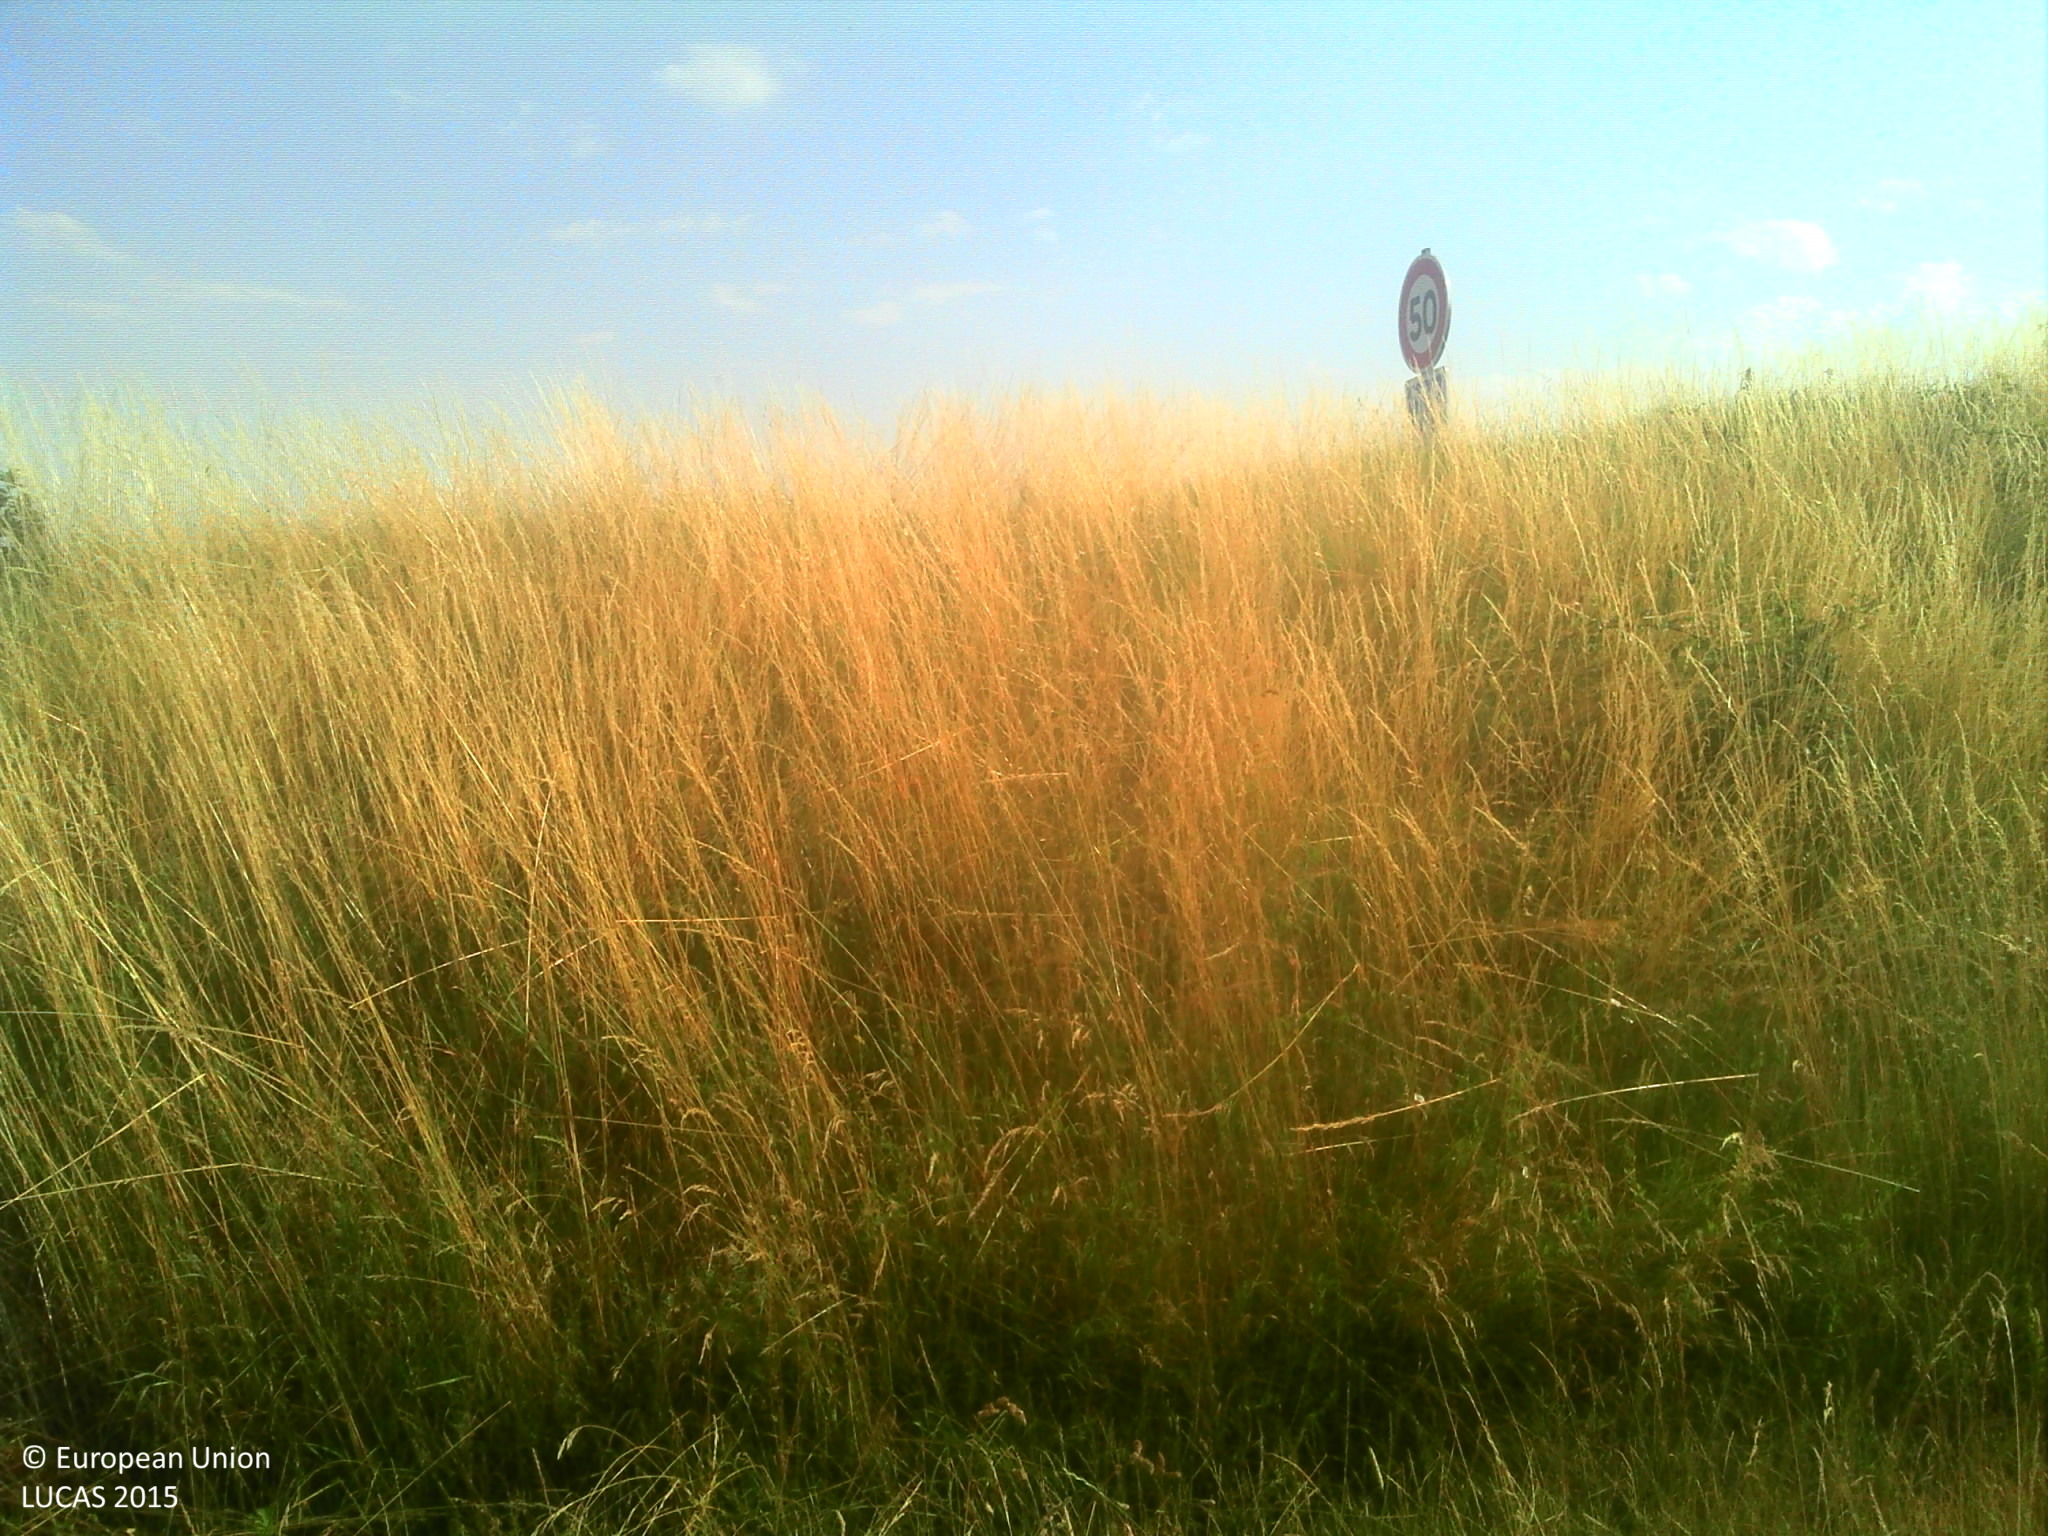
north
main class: Grassland
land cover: Grassland without tree/shrub cover
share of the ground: > 75 %
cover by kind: herbaceous plants 100 %
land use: Agriculture (excluding fallow land and kitchen gardens)
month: July
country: FR
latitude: 47.6557
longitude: 1.4507
